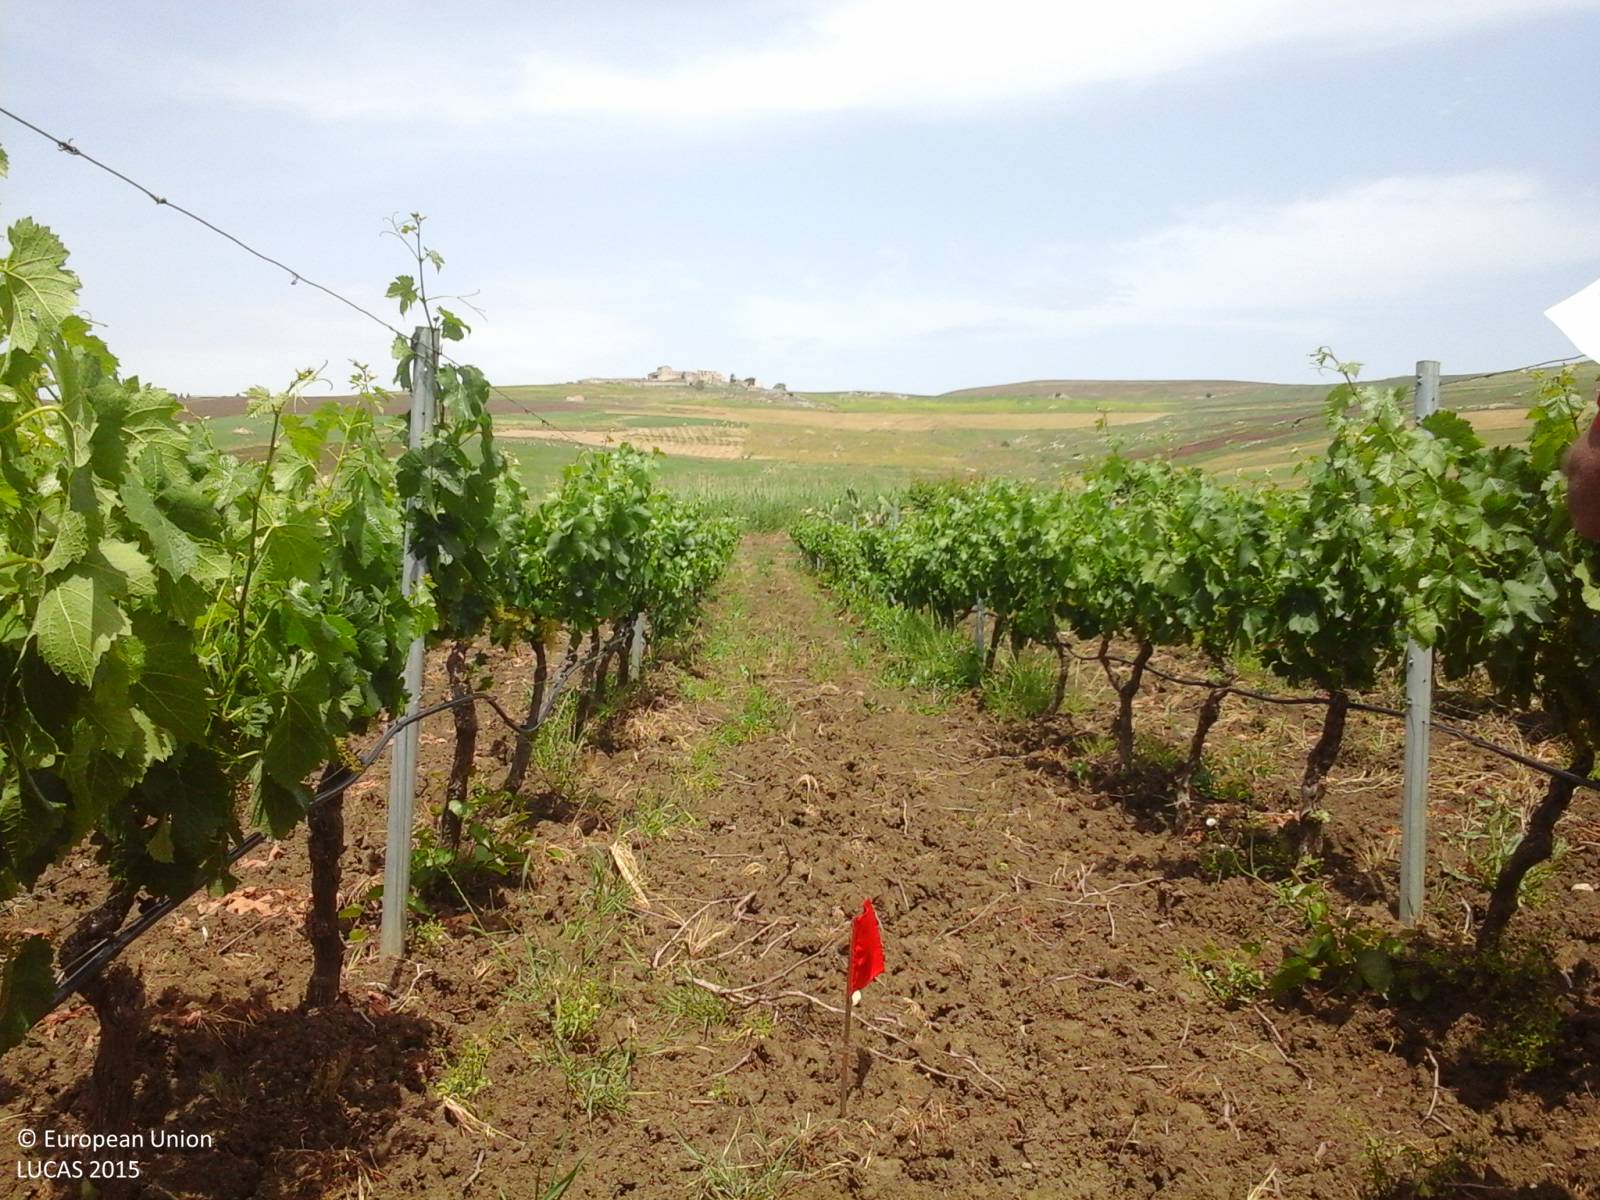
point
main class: Cropland
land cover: Vineyards
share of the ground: 50 - 75 %
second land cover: Other bare soil
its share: > 75 %
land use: Agriculture (excluding fallow land and kitchen gardens)
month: May
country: IT
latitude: 37.8582
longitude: 13.1707
